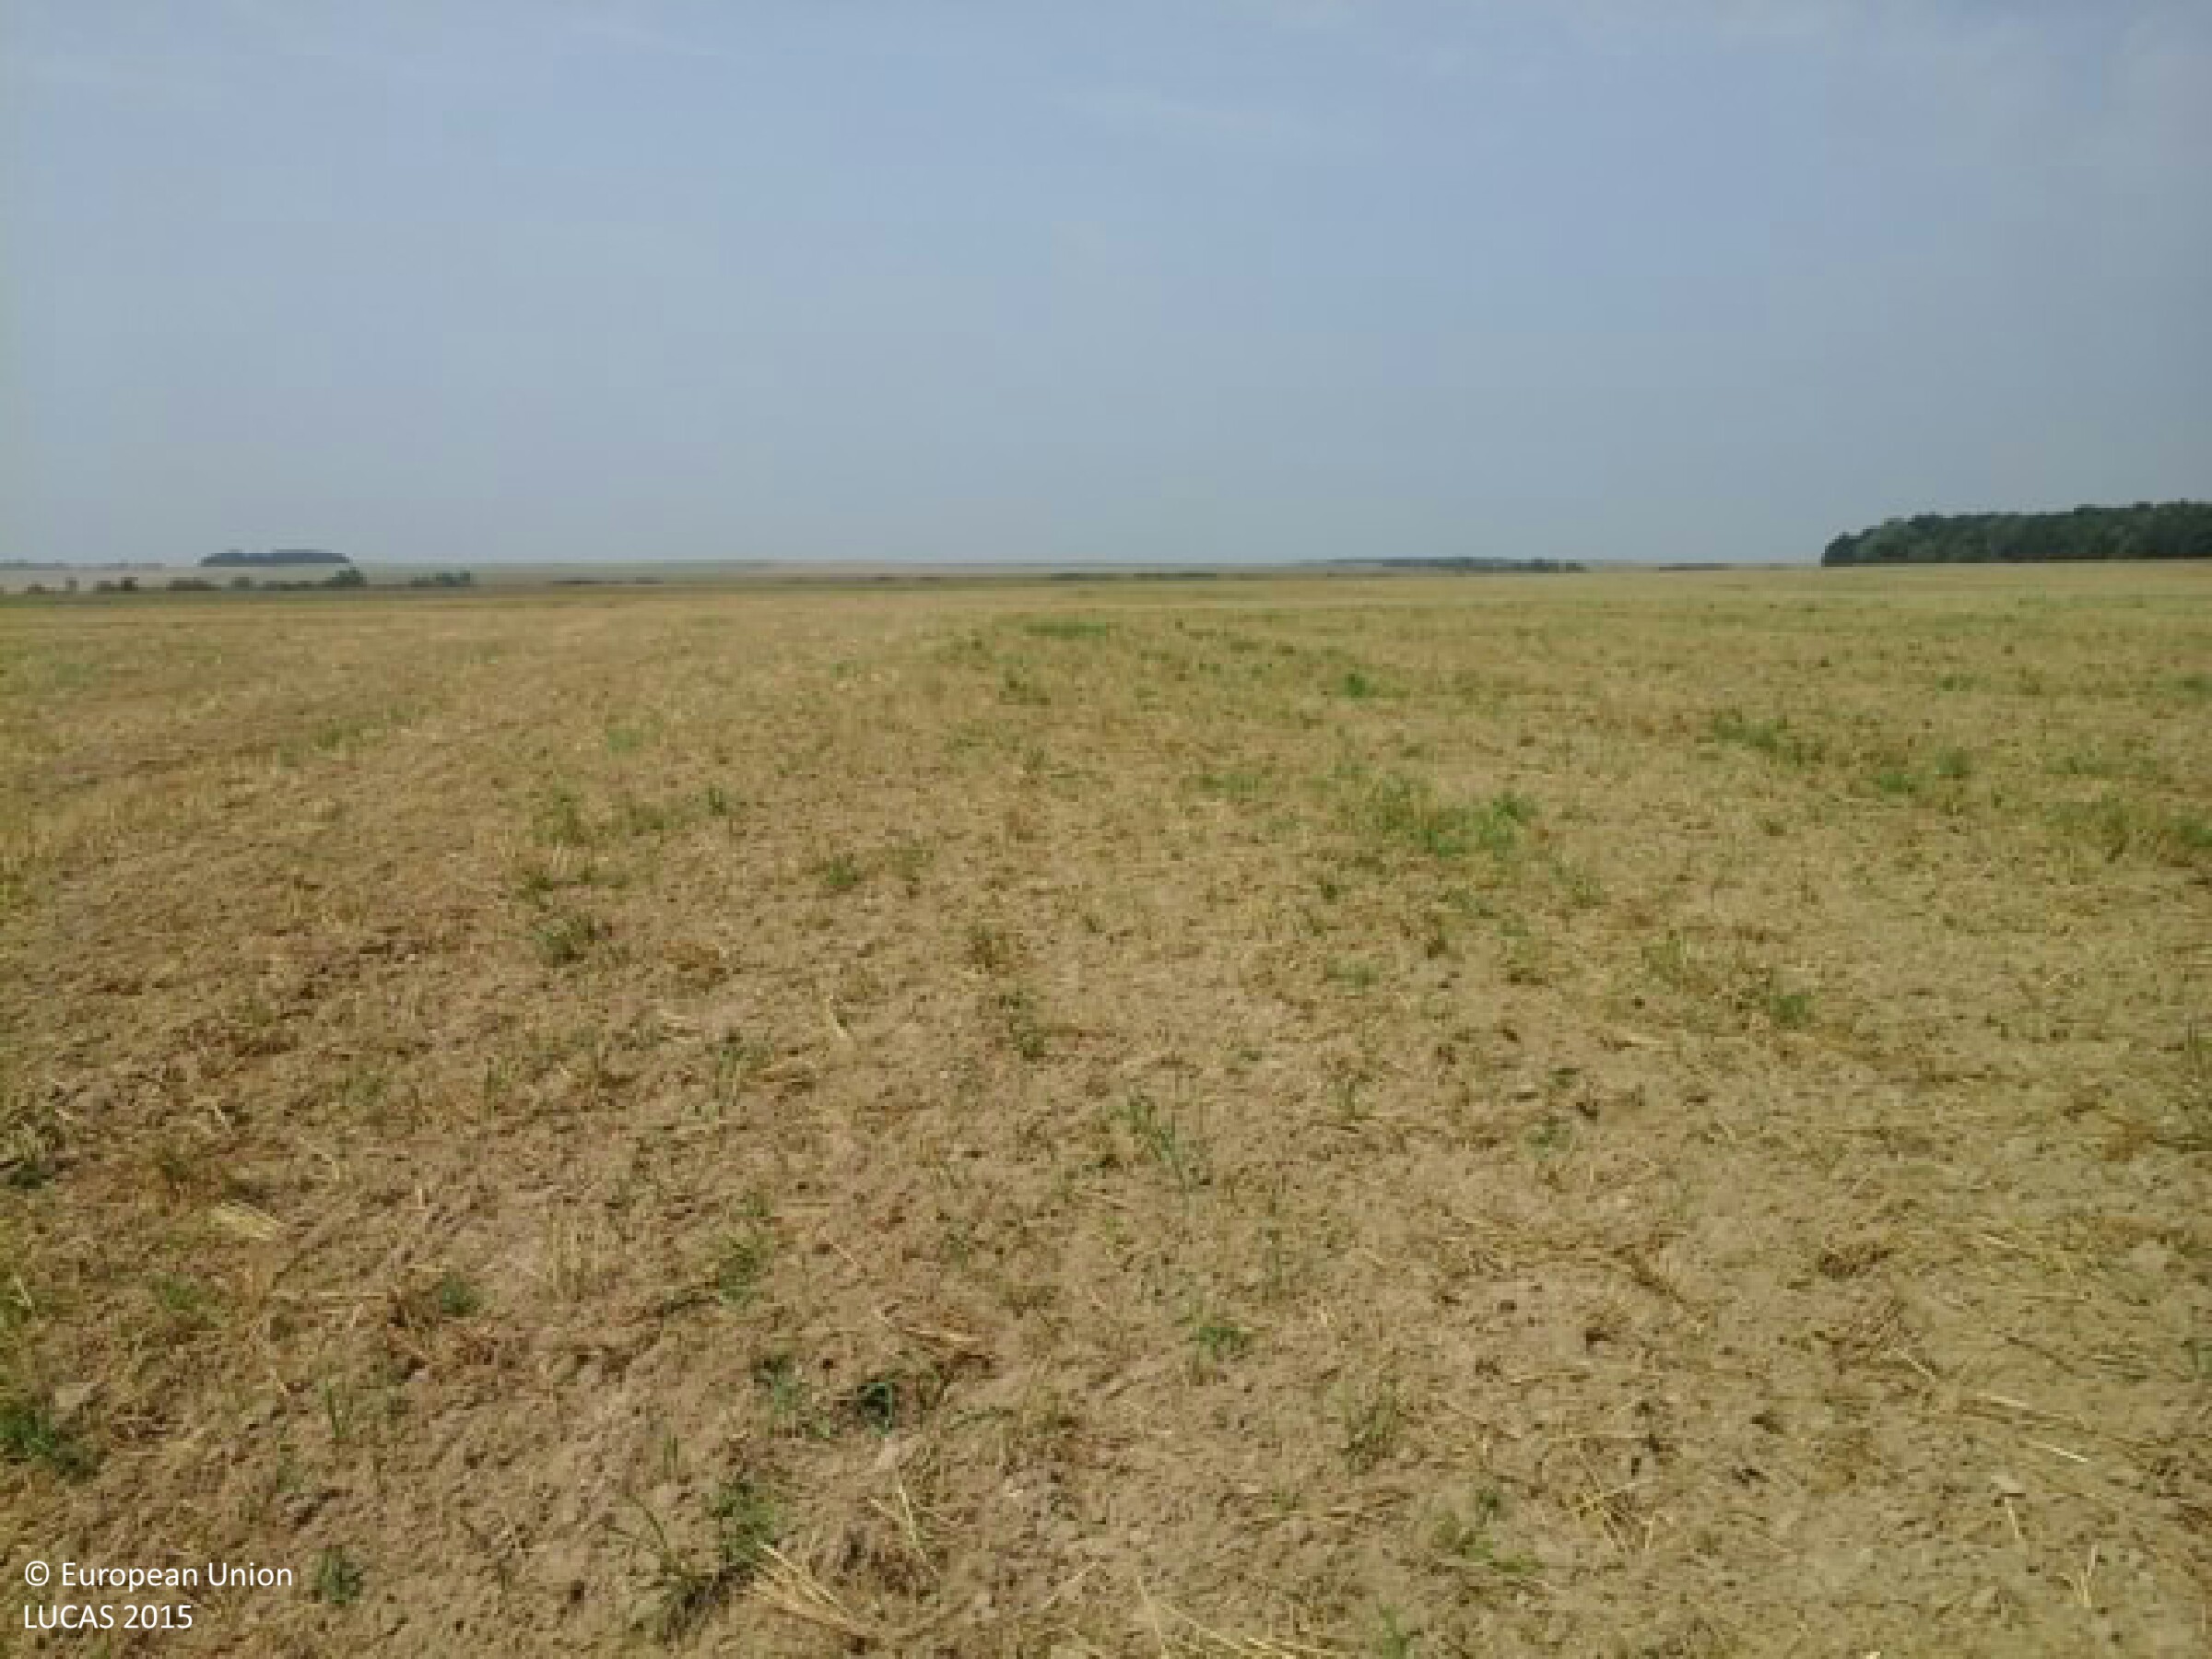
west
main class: Cropland
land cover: Common wheat
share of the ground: < 10 %
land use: Agriculture (excluding fallow land and kitchen gardens)
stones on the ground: < 10 %
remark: Harvested field
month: August
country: HU
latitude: 46.3835
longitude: 17.1414
